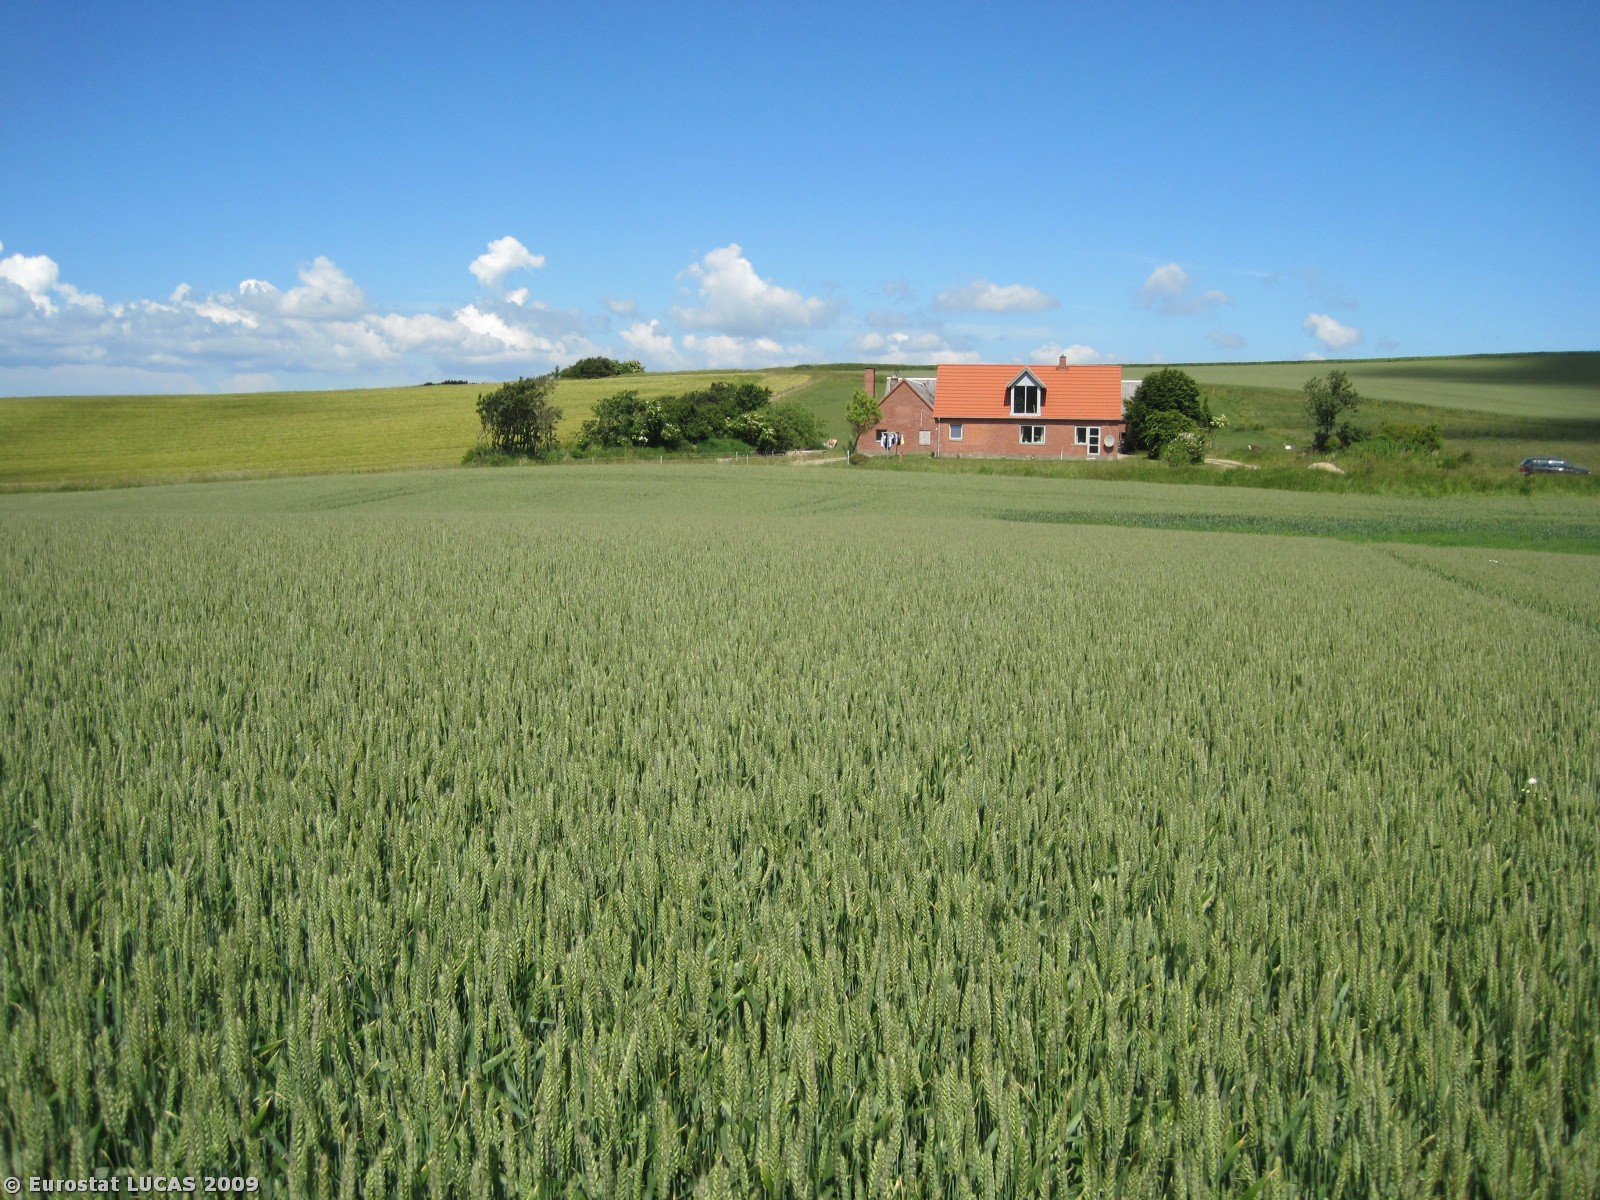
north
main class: Cropland
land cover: Common wheat
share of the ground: > 75 %
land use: Agriculture (excluding fallow land and kitchen gardens)
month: June
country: DK
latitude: 56.8824
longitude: 8.7054
